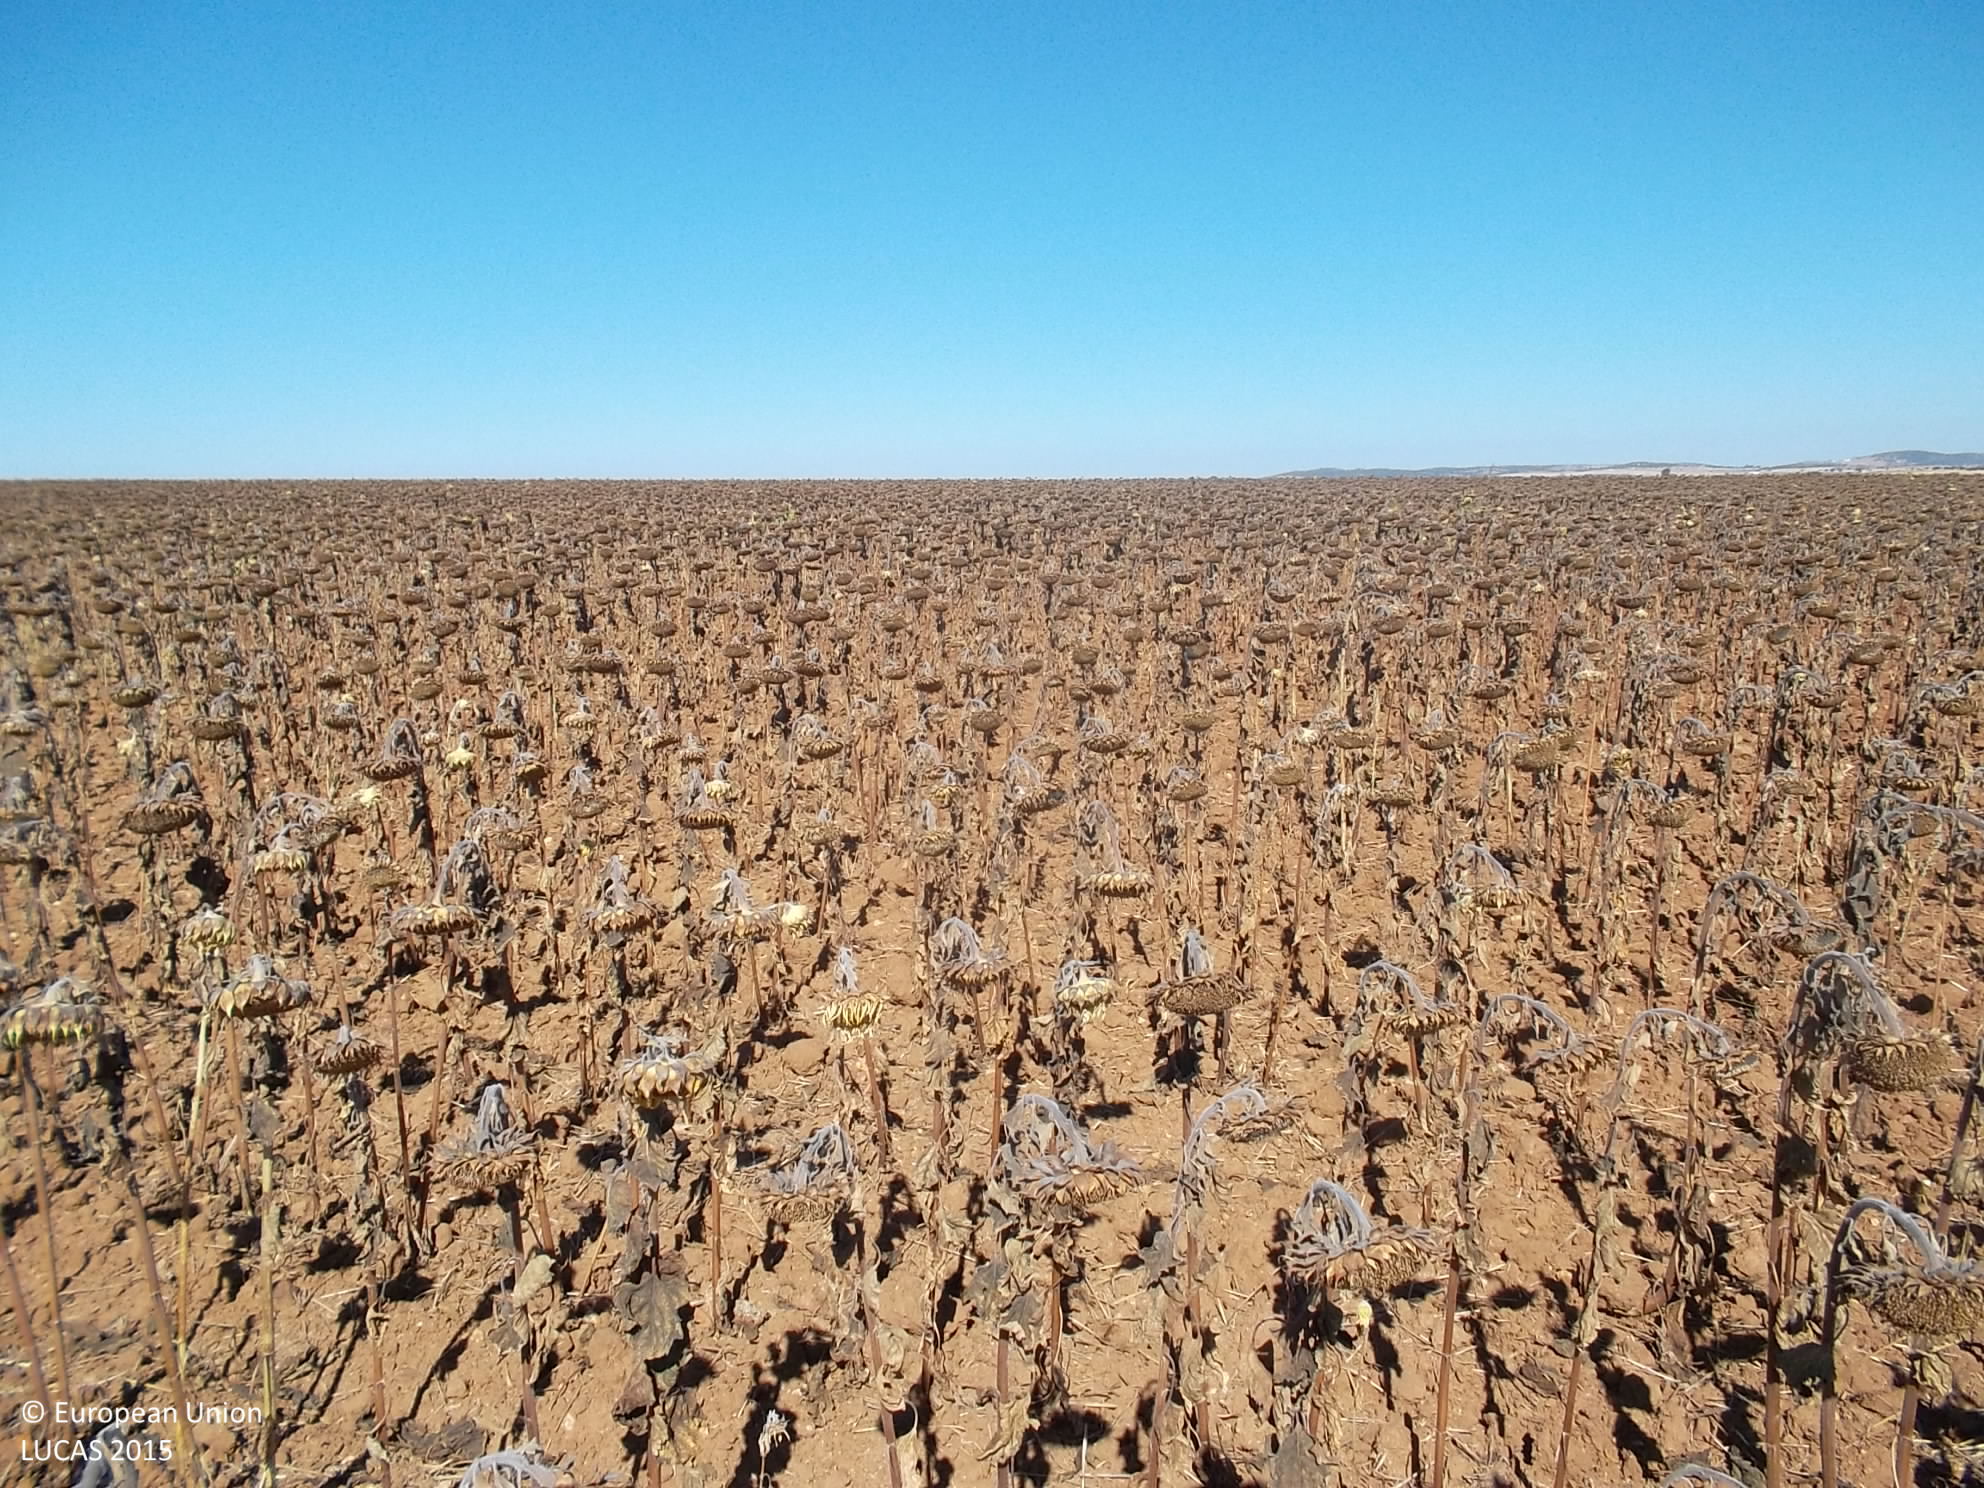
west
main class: Cropland
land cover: Sunflower
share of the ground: > 75 %
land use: Agriculture (excluding fallow land and kitchen gardens)
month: July
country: ES
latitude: 38.4033
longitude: -5.7138
